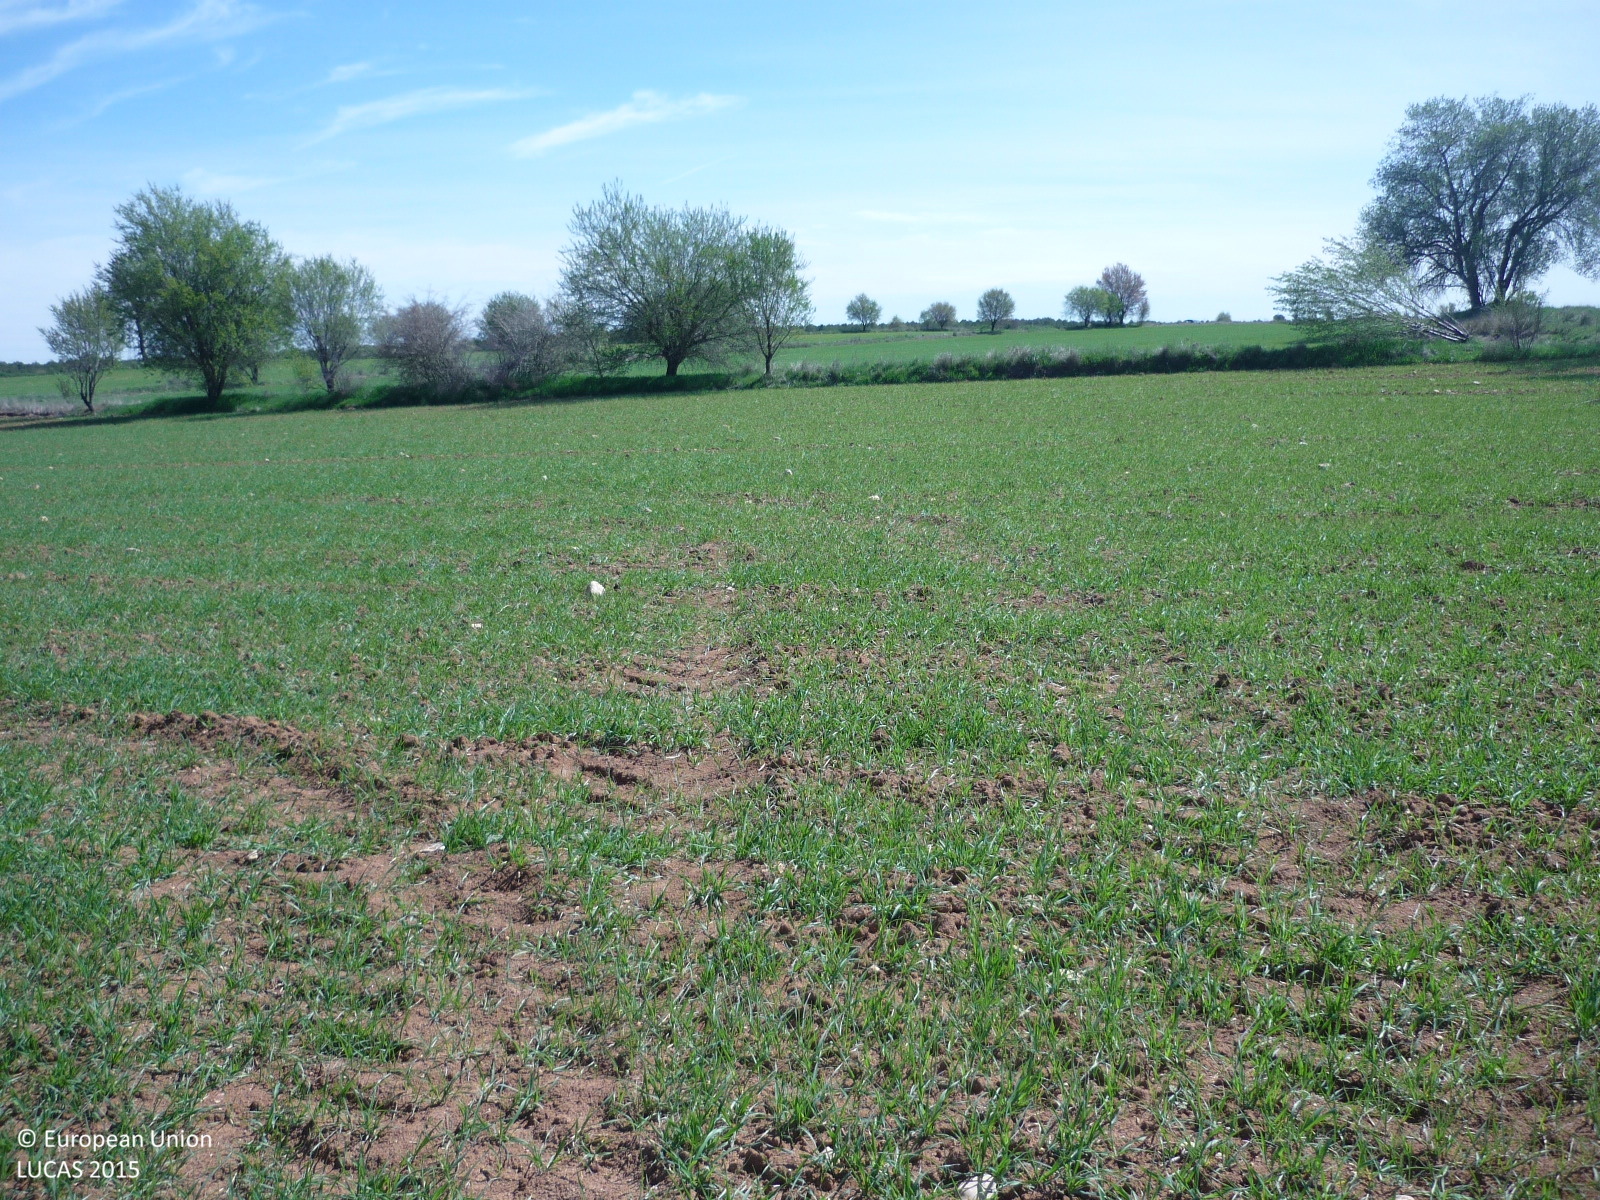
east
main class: Cropland
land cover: Barley
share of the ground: 50 - 75 %
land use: Agriculture (excluding fallow land and kitchen gardens)
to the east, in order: Barley; Groves; Oats; Grass margins; Barley; Groves; Common wheat
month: March
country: ES
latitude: 40.3847
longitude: -3.2839
